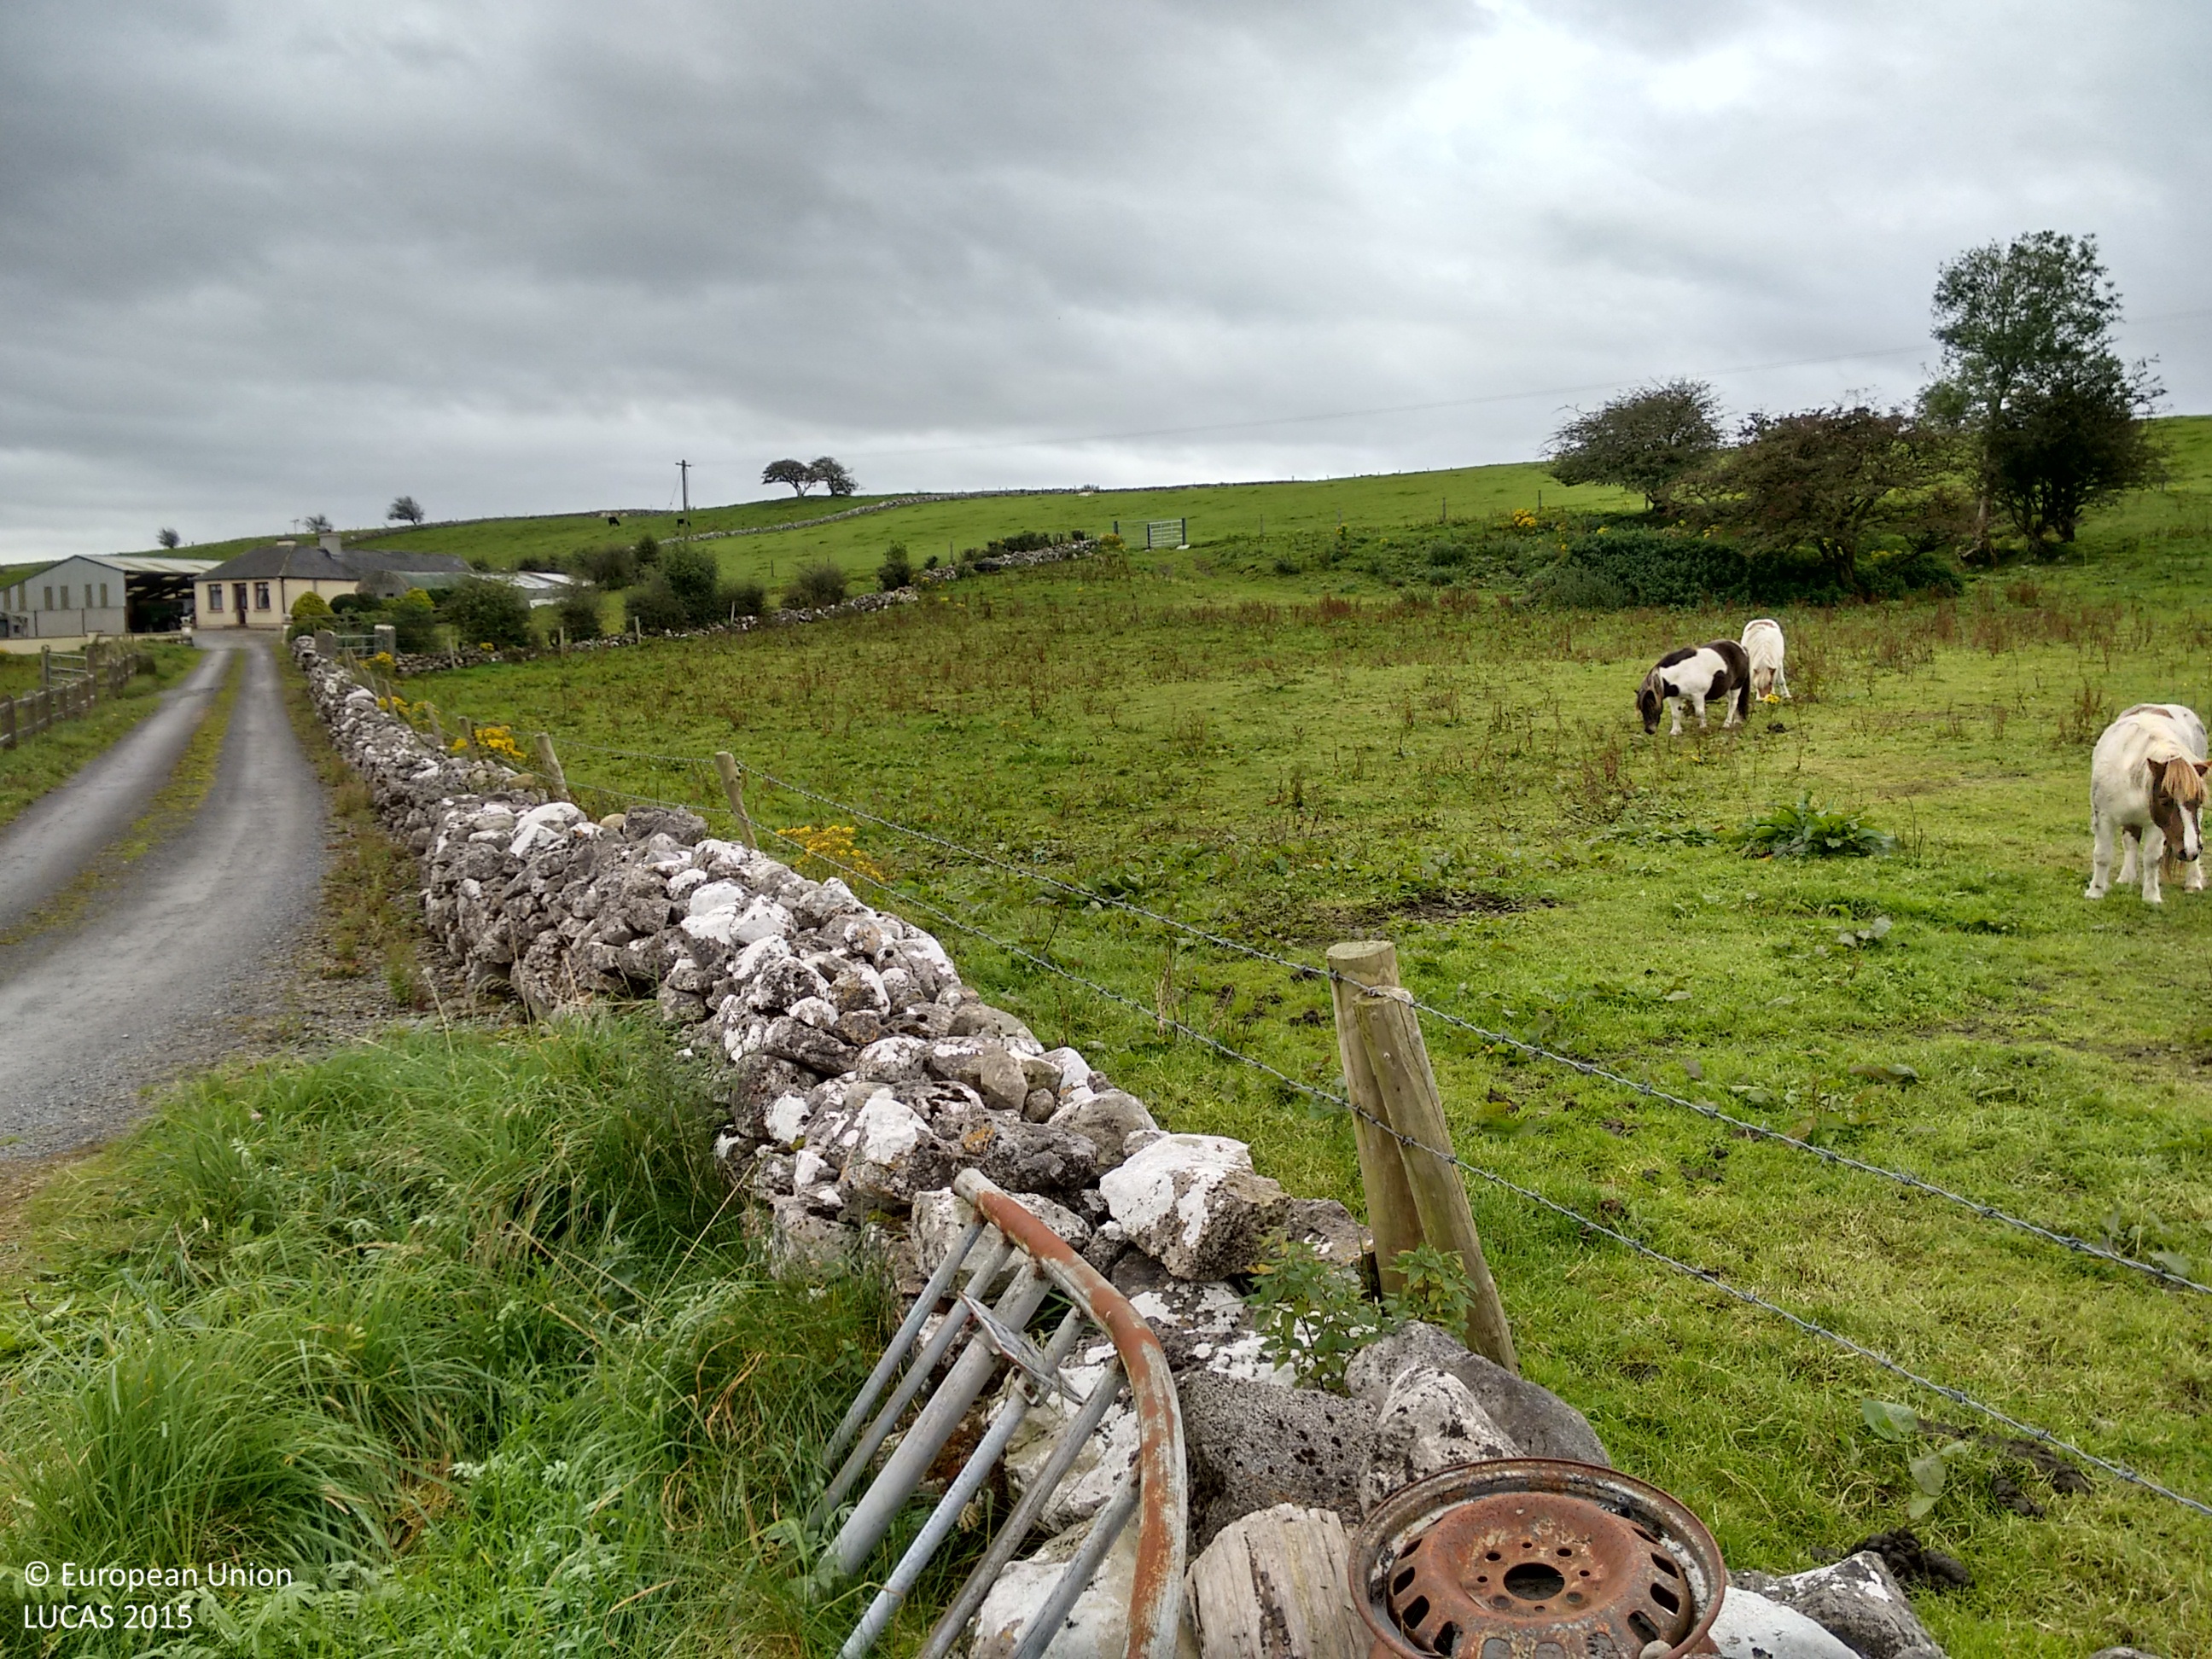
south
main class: Grassland
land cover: Grassland without tree/shrub cover
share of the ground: > 75 %
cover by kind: herbaceous plants 100 %
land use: Agriculture (excluding fallow land and kitchen gardens)
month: September
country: IE
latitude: 53.8479
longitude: -8.8253
